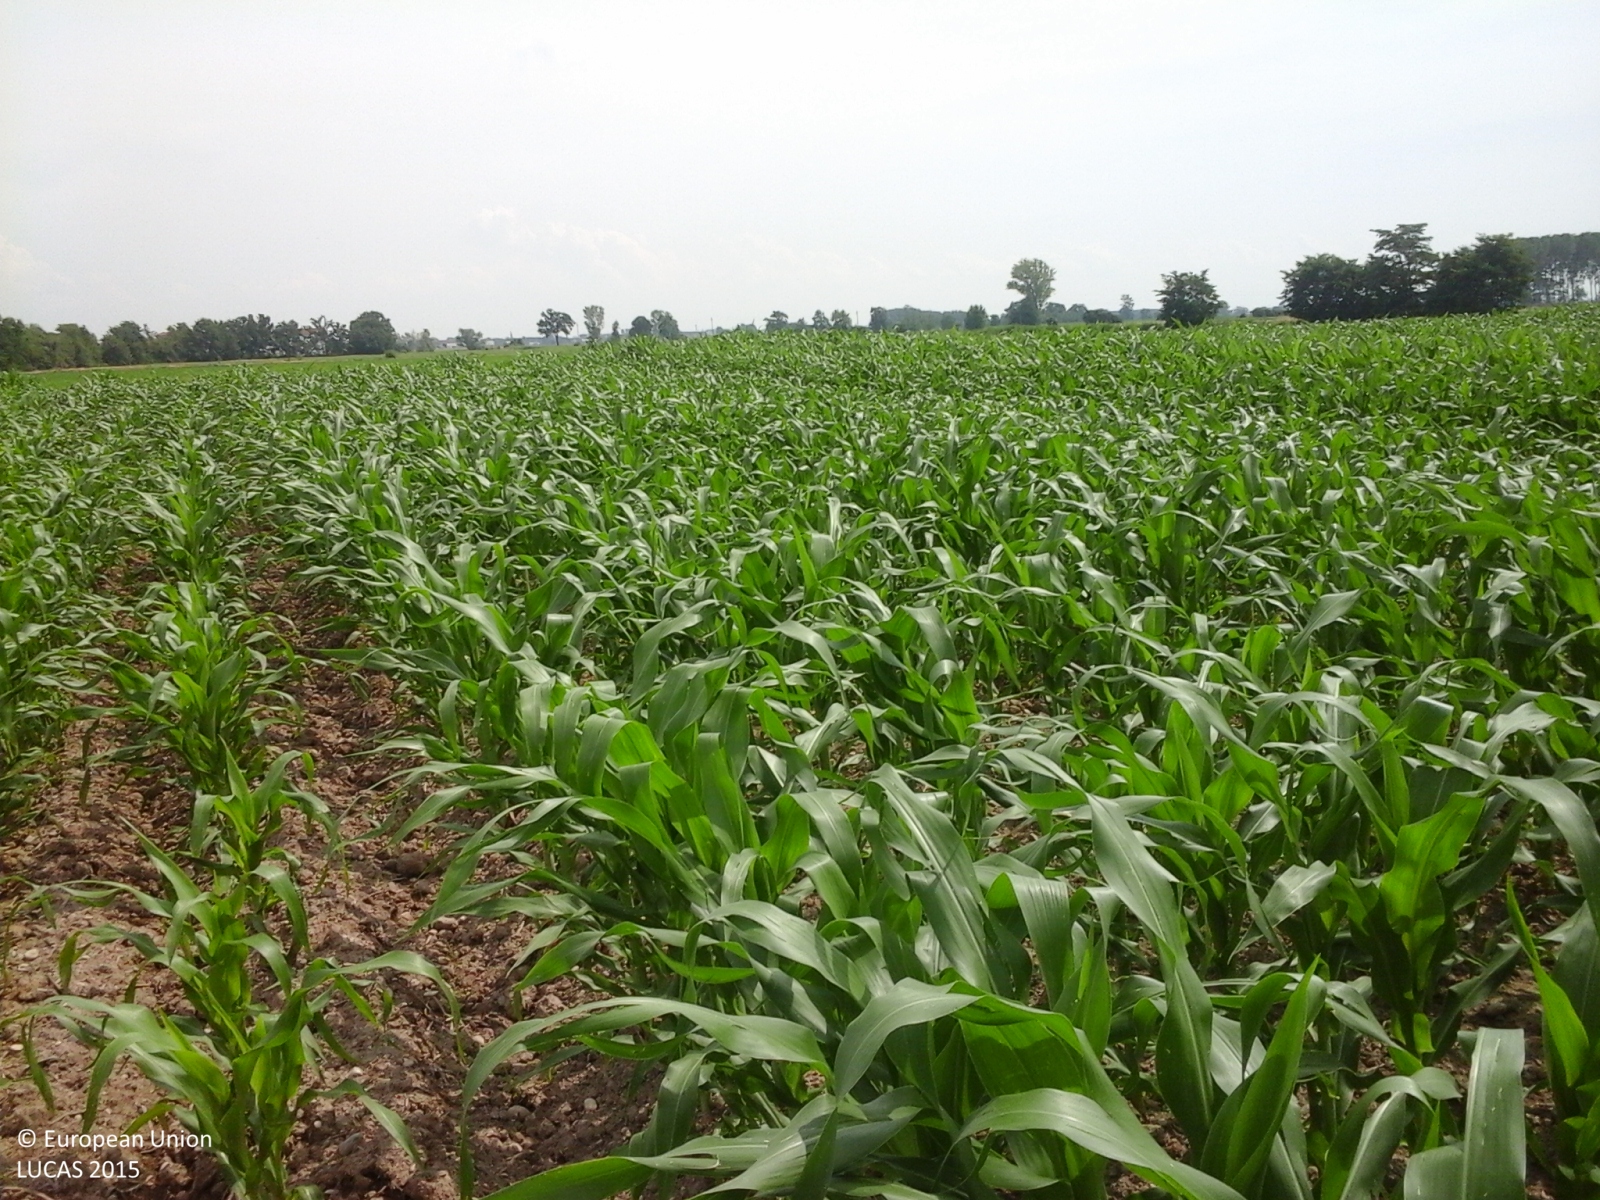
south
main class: Cropland
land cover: Maize
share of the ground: 50 - 75 %
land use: Agriculture (excluding fallow land and kitchen gardens)
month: June
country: IT
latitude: 45.3884
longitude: 8.7122
